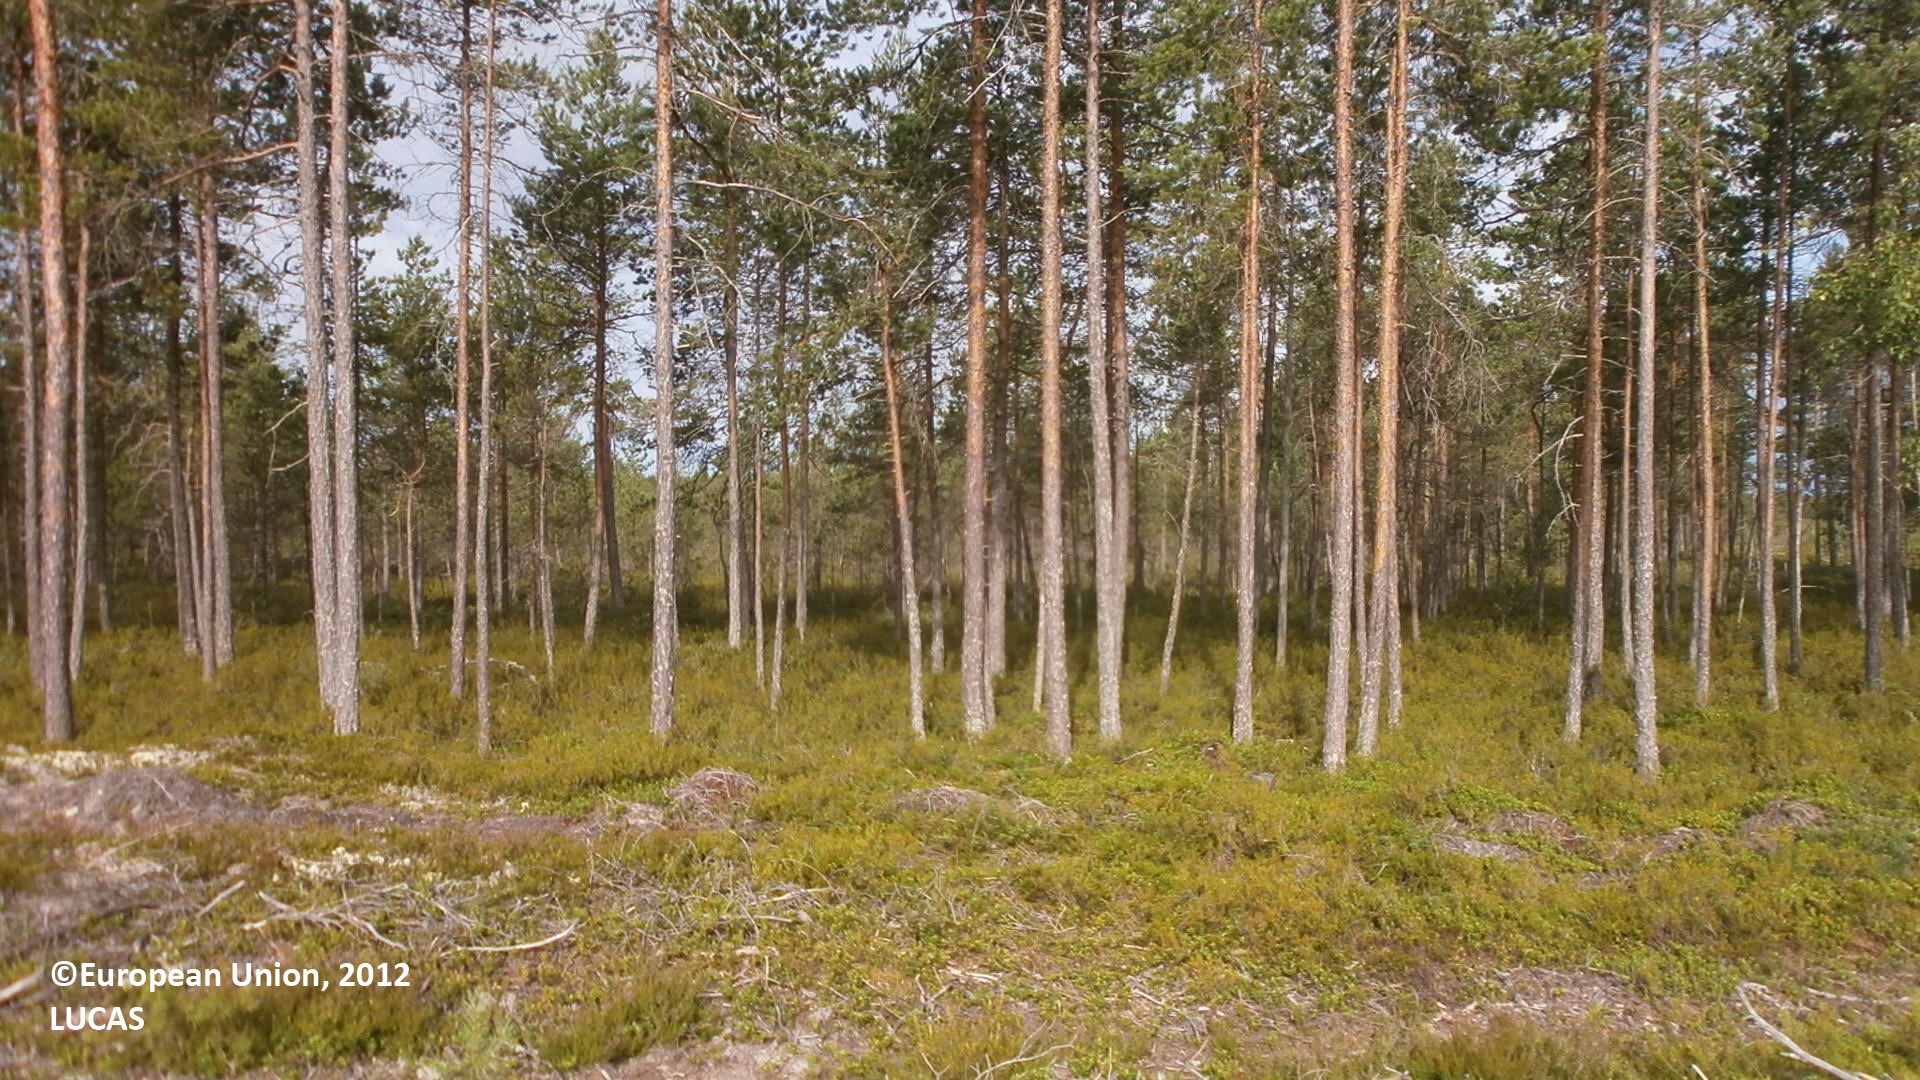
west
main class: Woodland
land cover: Pine dominated coniferous woodland
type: boreal forest
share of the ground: 10 - 25 %
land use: Forestry
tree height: < 5 m
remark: Clear cut
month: July
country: FI
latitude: 64.0837
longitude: 24.0304
